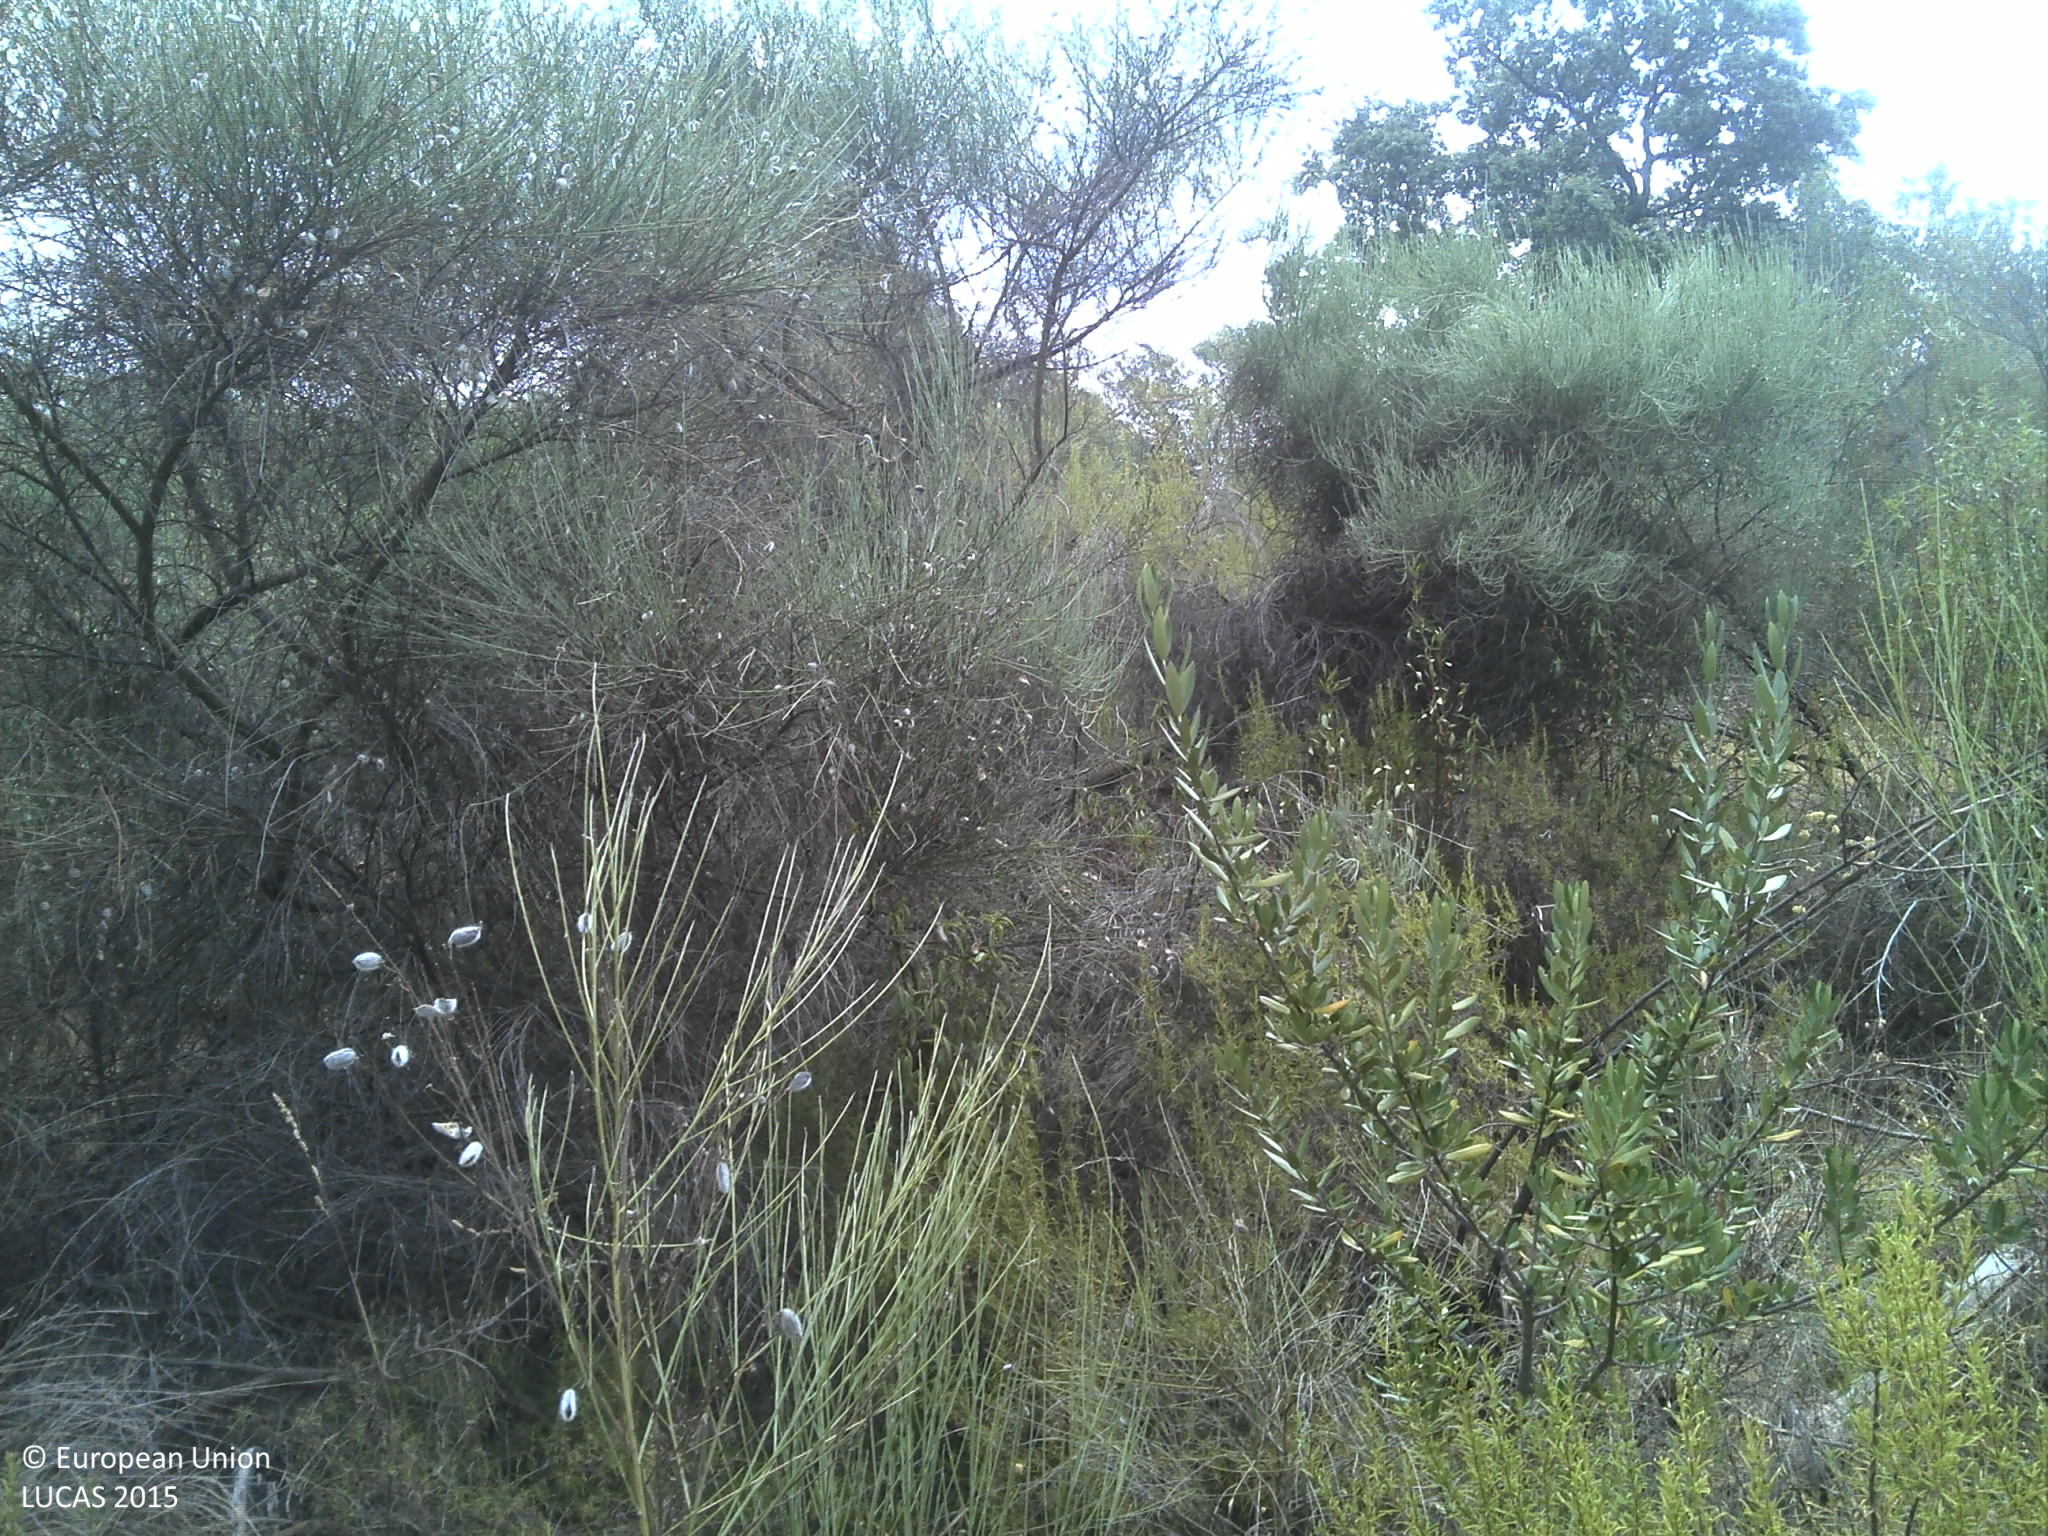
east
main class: Woodland
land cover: Pine dominated coniferous woodland
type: coniferous forest of the mediterranean region
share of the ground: 25 - 50 %
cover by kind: coniferous forest trees 45 %, shrubs 40 %, herbaceous plants 5 %, unconsolidated bare surface 5 %
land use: Forestry
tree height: > 5 m
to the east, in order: Pine dominated coniferous woodland; Rivers and streams; Shrubland with sparse tree cover; Olive groves; Shrubland with sparse tree cover; Dry stone walls; Olive groves; Broadleaved woodland
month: July
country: PT
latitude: 39.8465
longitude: -7.3820
